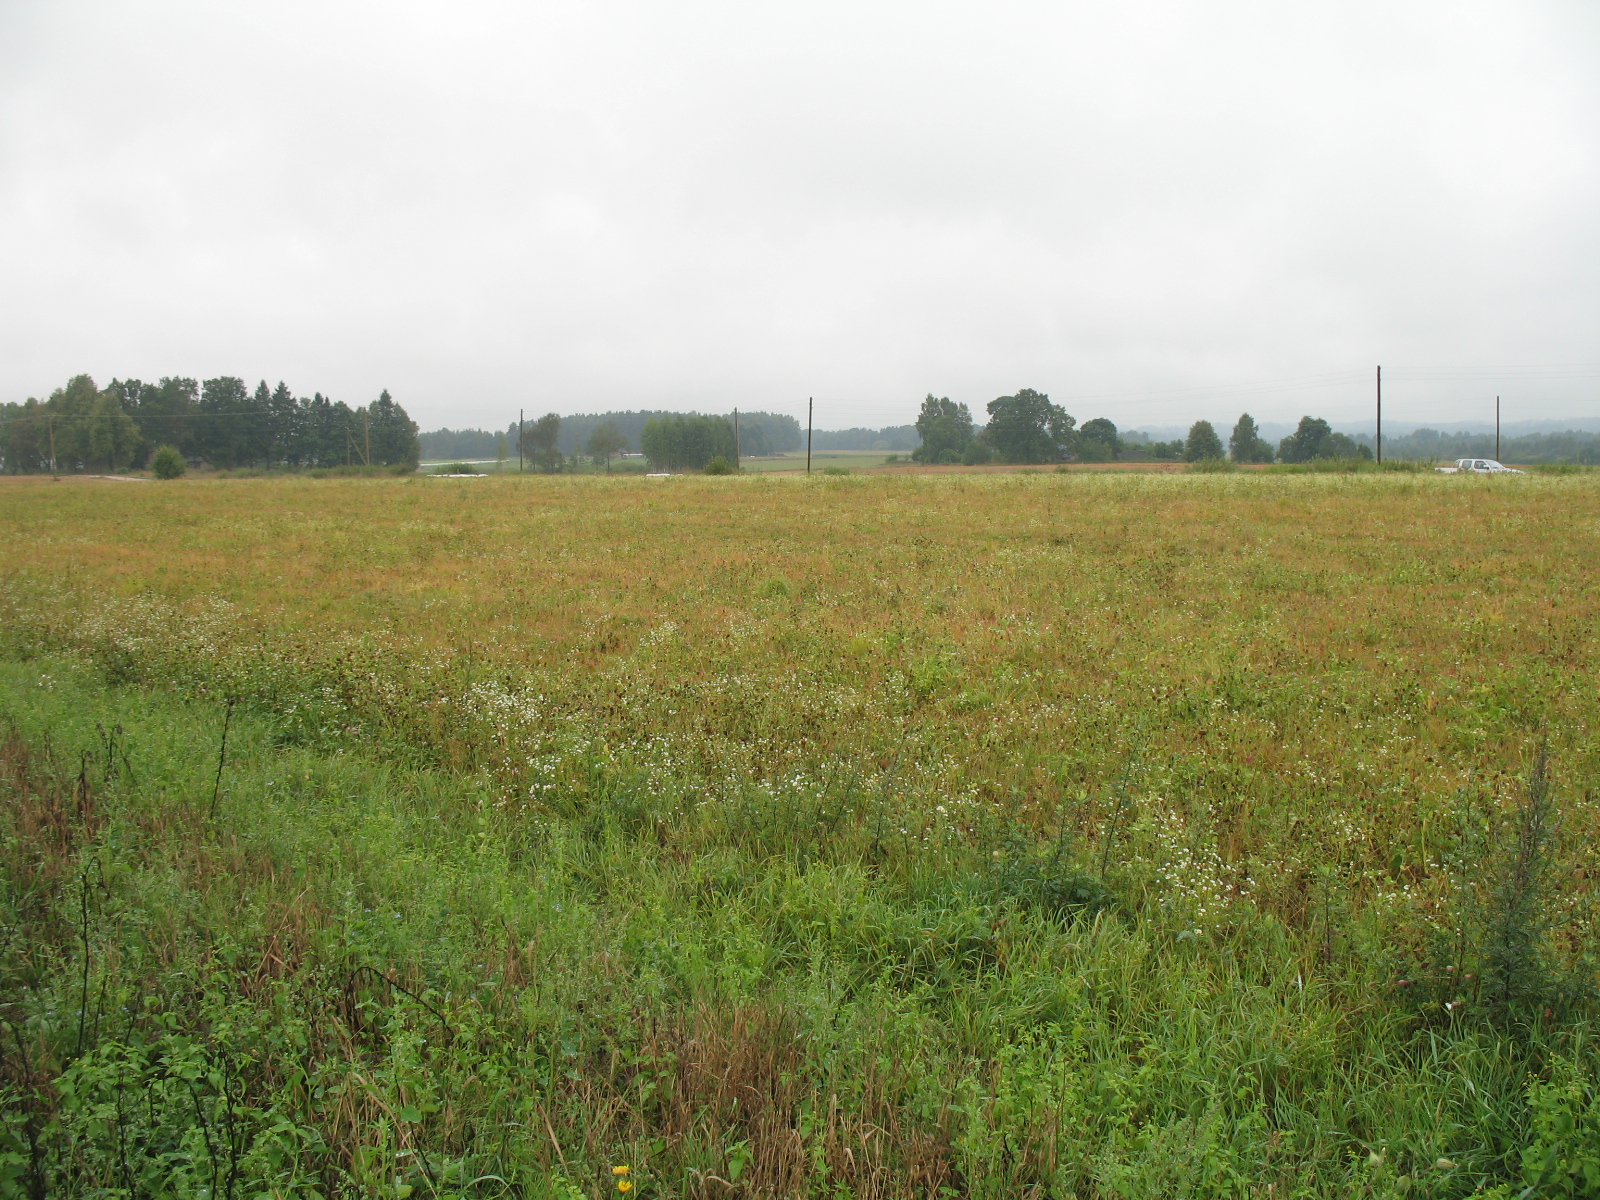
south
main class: Grassland
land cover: Spontaneously vegetated surfaces
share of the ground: > 75 %
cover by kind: herbaceous plants 80 %, unconsolidated bare surface 20 %
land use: Fallow land
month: September
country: LV
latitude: 56.0822
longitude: 26.2268
